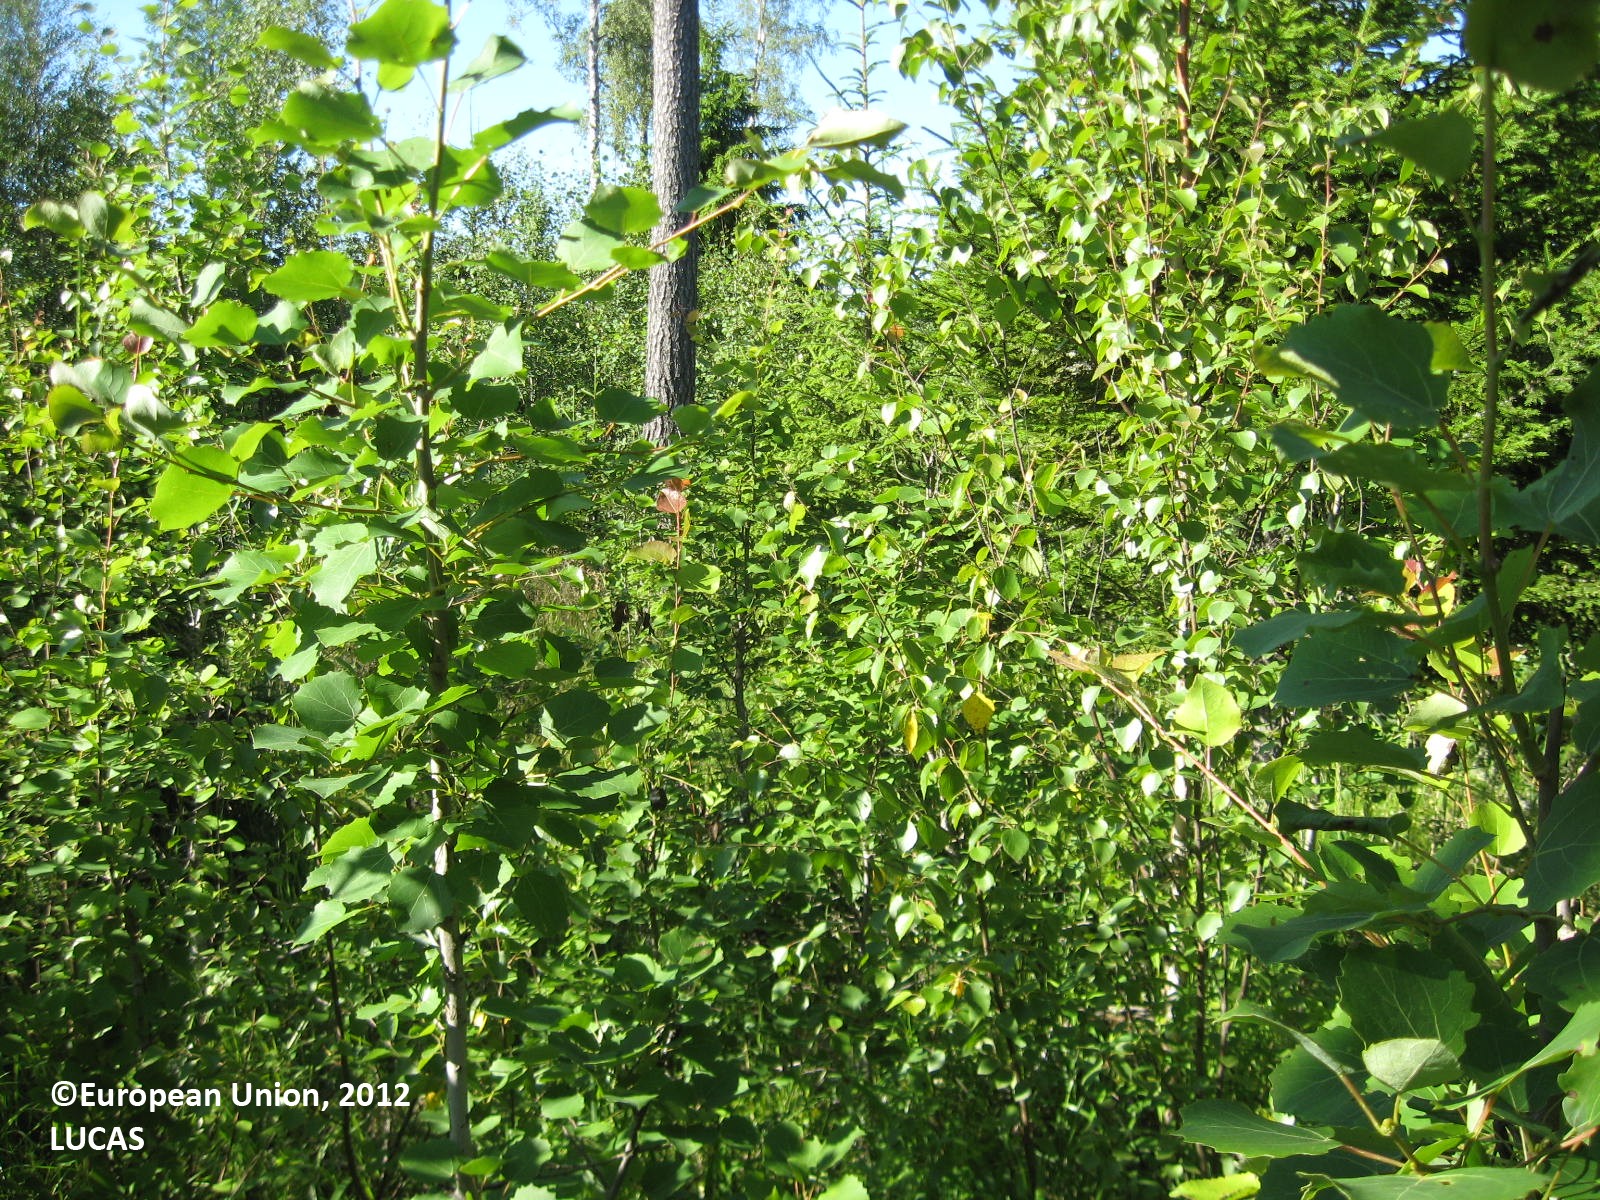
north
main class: Woodland
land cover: Broadleaved woodland
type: boreal forest
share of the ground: > 75 %
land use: Forestry
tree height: > 5 m
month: July
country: FI
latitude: 62.1400
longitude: 21.4199
